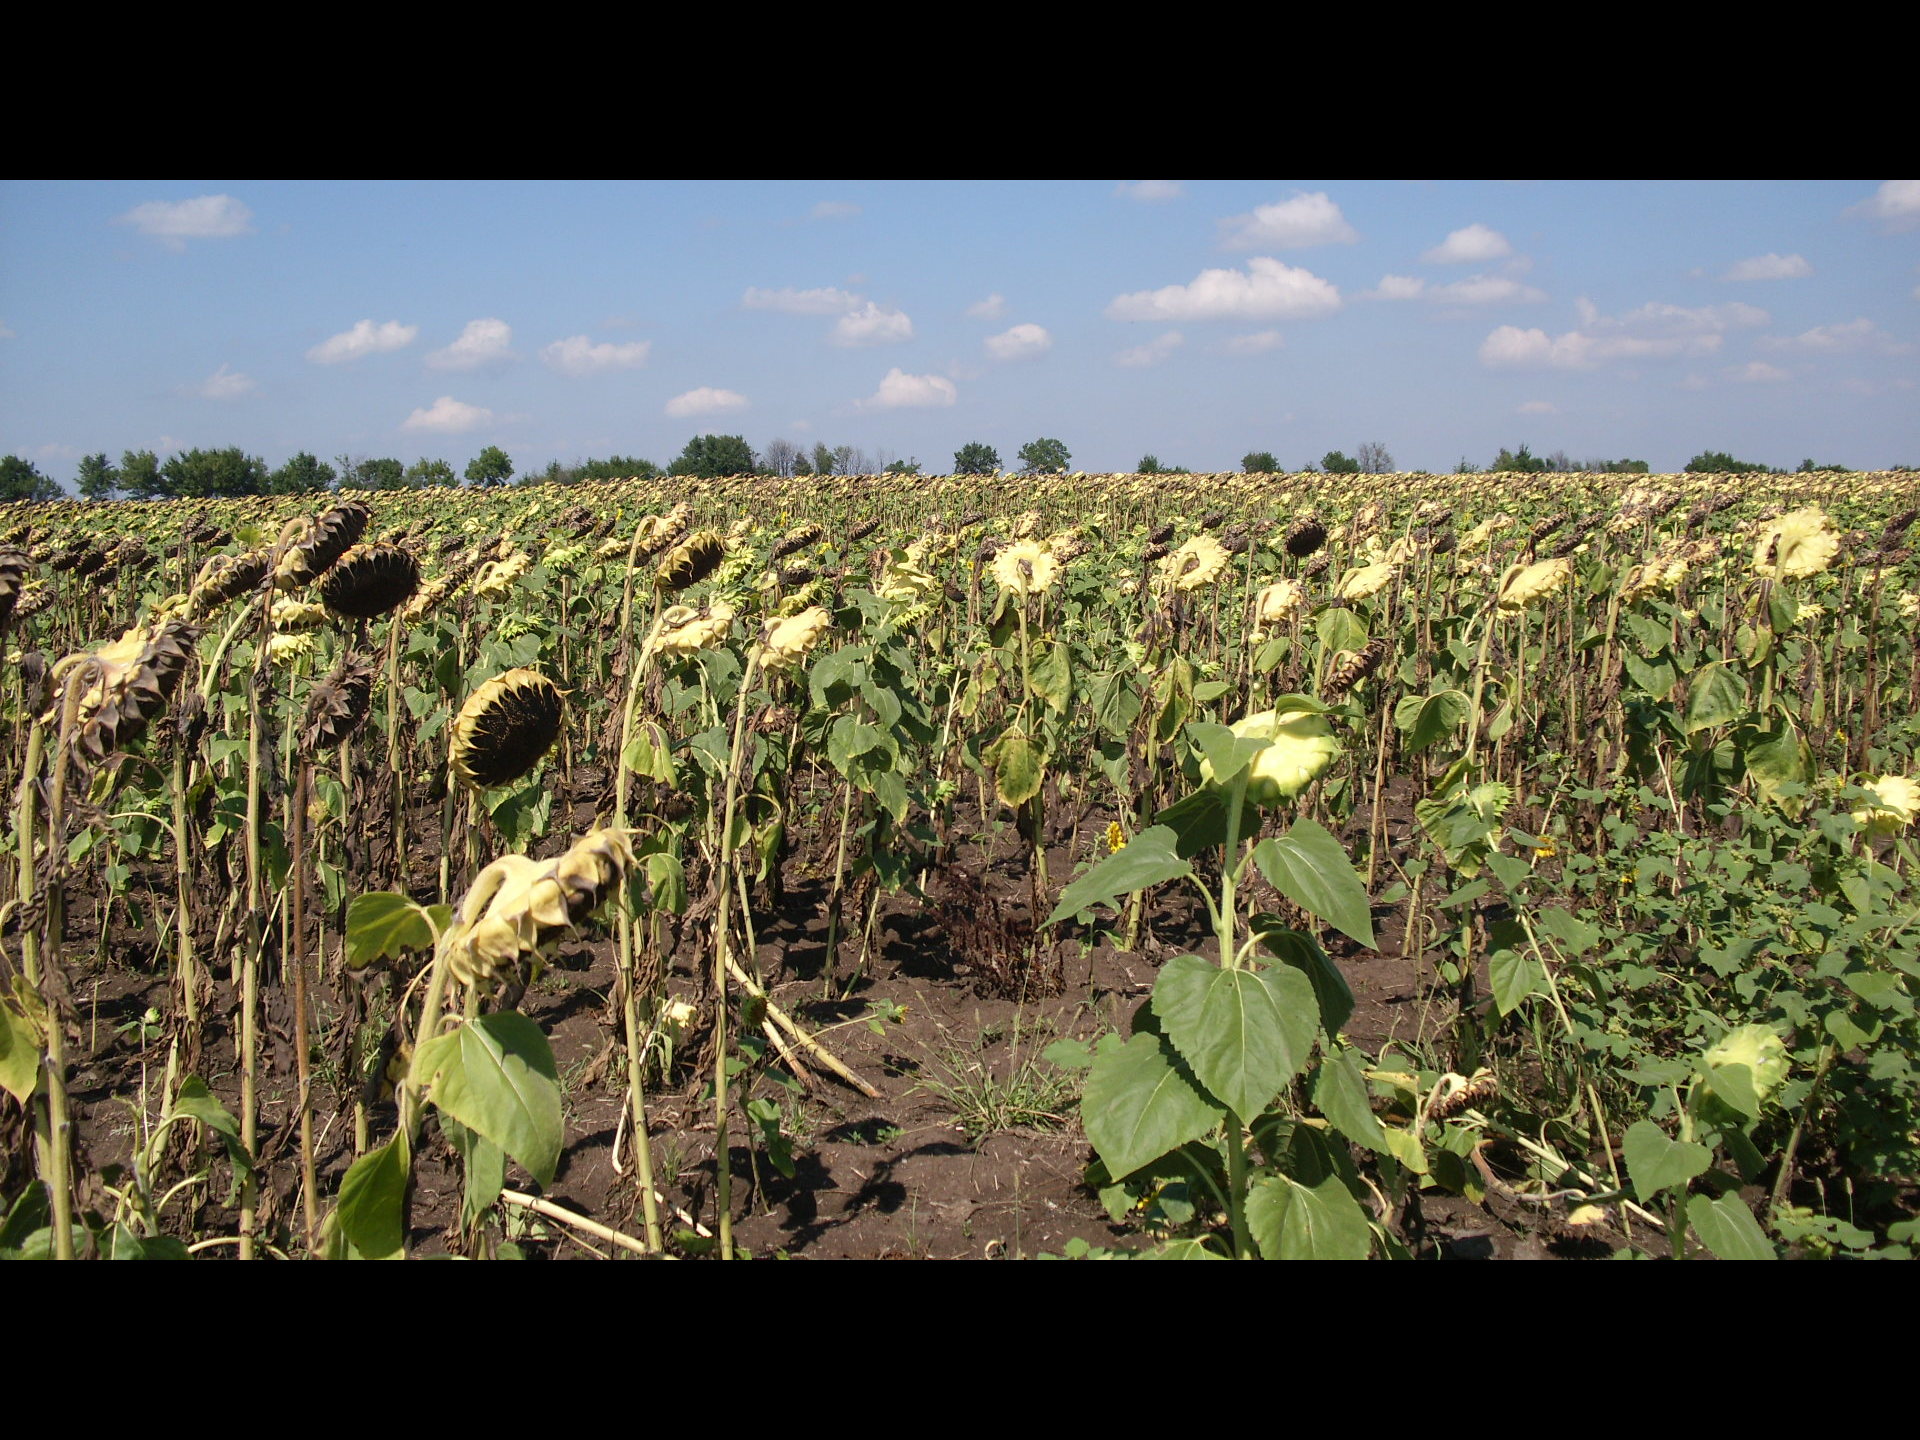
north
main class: Cropland
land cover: Sunflower
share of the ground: > 75 %
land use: Agriculture (excluding fallow land and kitchen gardens)
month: August
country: BG
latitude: 43.6216
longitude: 22.9881
